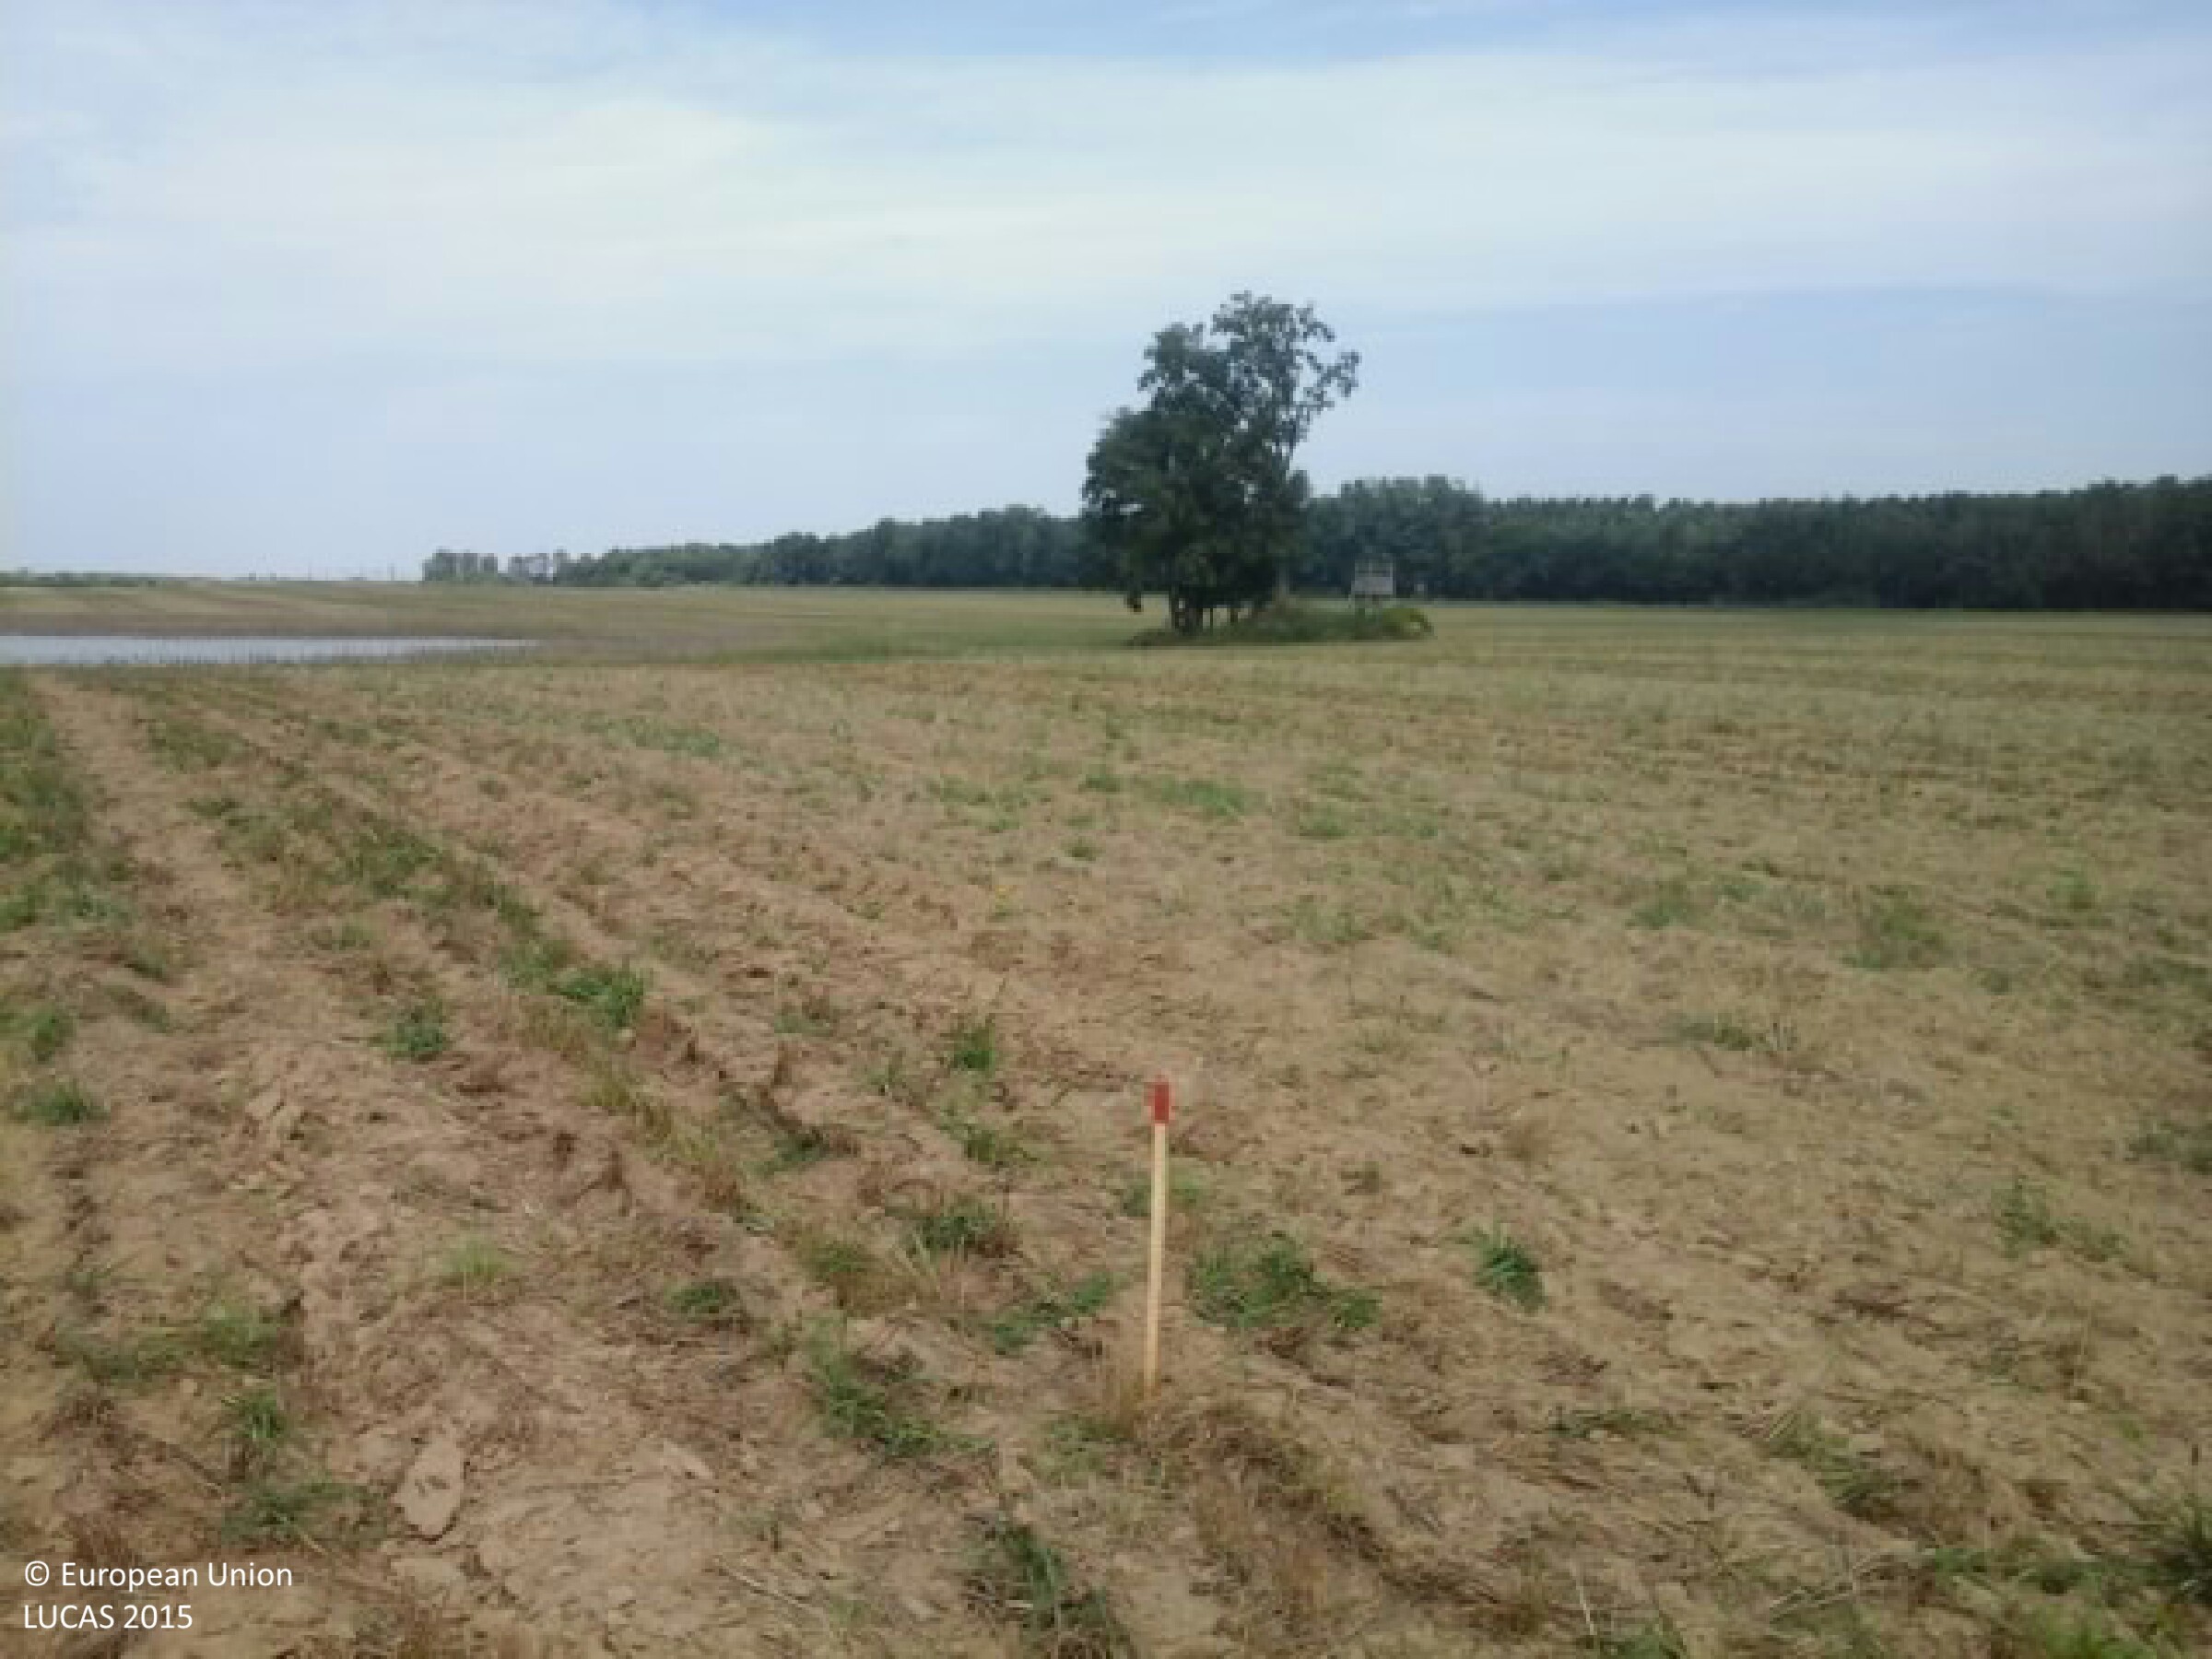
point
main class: Cropland
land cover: Common wheat
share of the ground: 25 - 50 %
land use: Agriculture (excluding fallow land and kitchen gardens)
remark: Harvested field
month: August
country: HU
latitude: 46.5557
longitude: 17.2694
